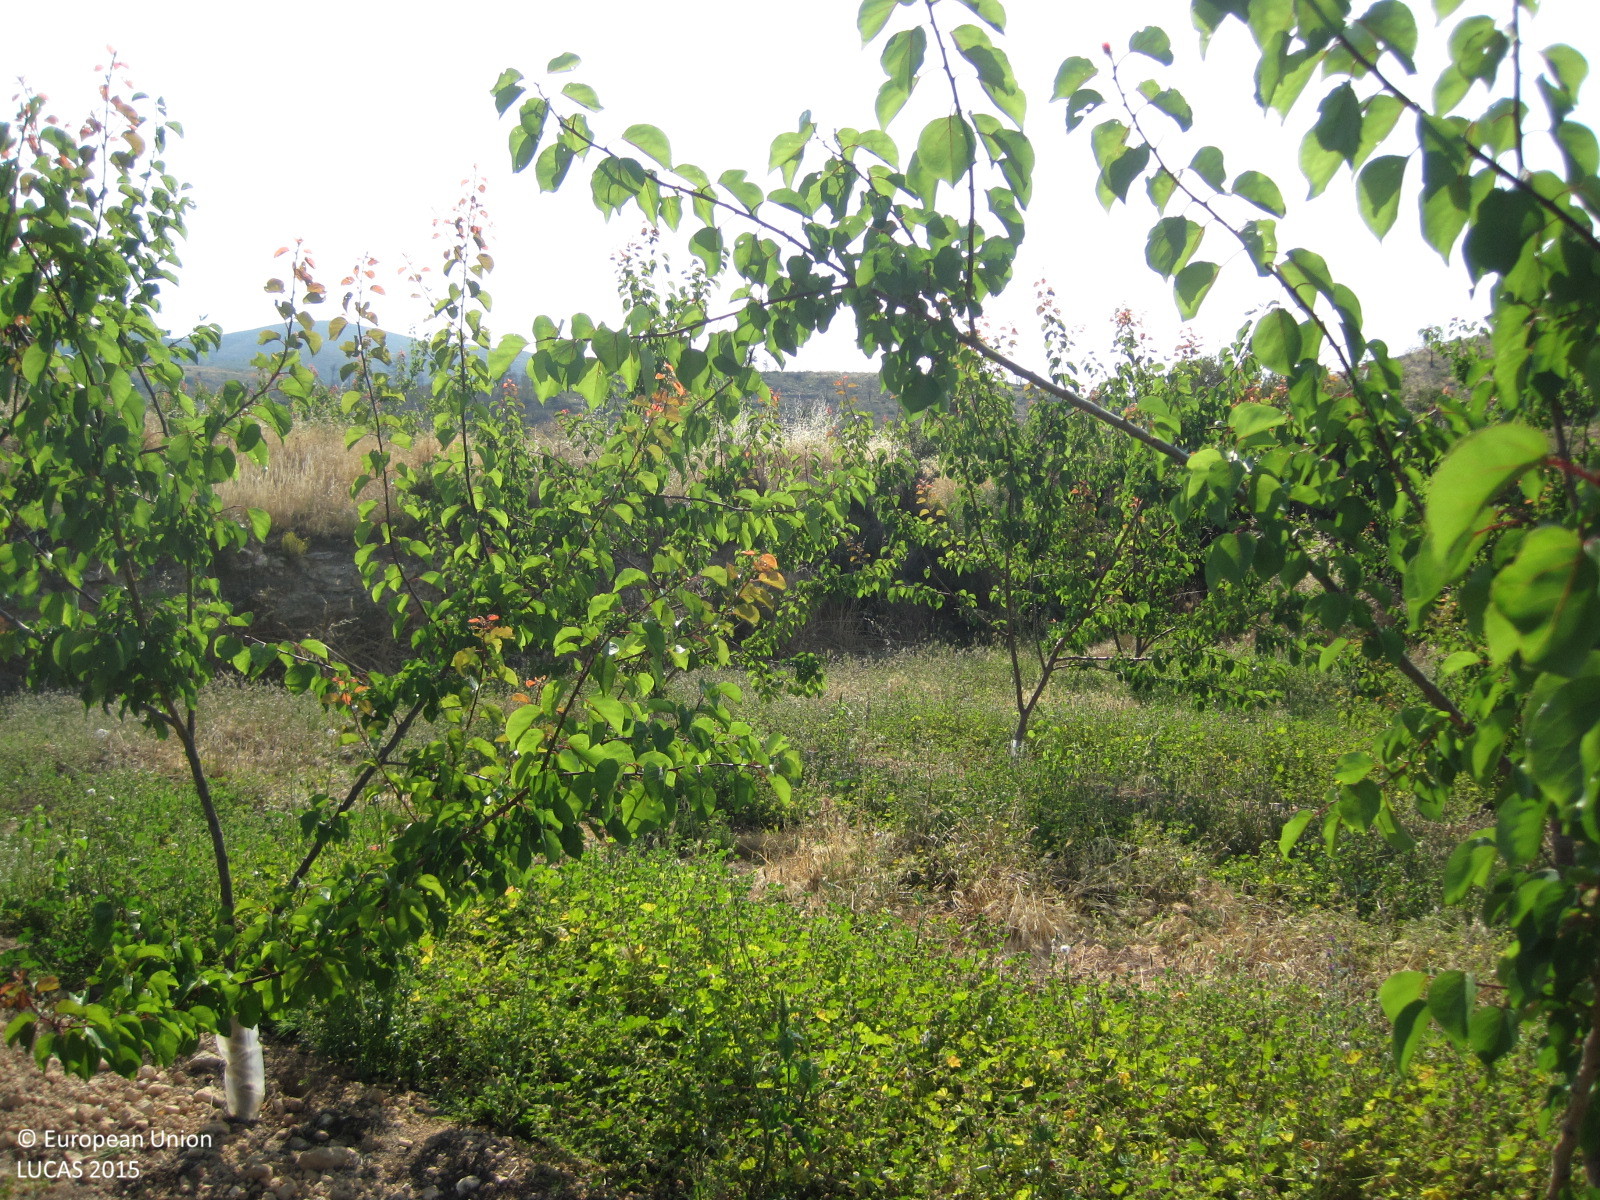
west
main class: Cropland
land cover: Other fruit trees and berries
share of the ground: 10 - 25 %
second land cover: Spontaneously vegetated surfaces
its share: > 75 %
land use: Agriculture (excluding fallow land and kitchen gardens)
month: June
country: ES
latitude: 39.3025
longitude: -0.6537
